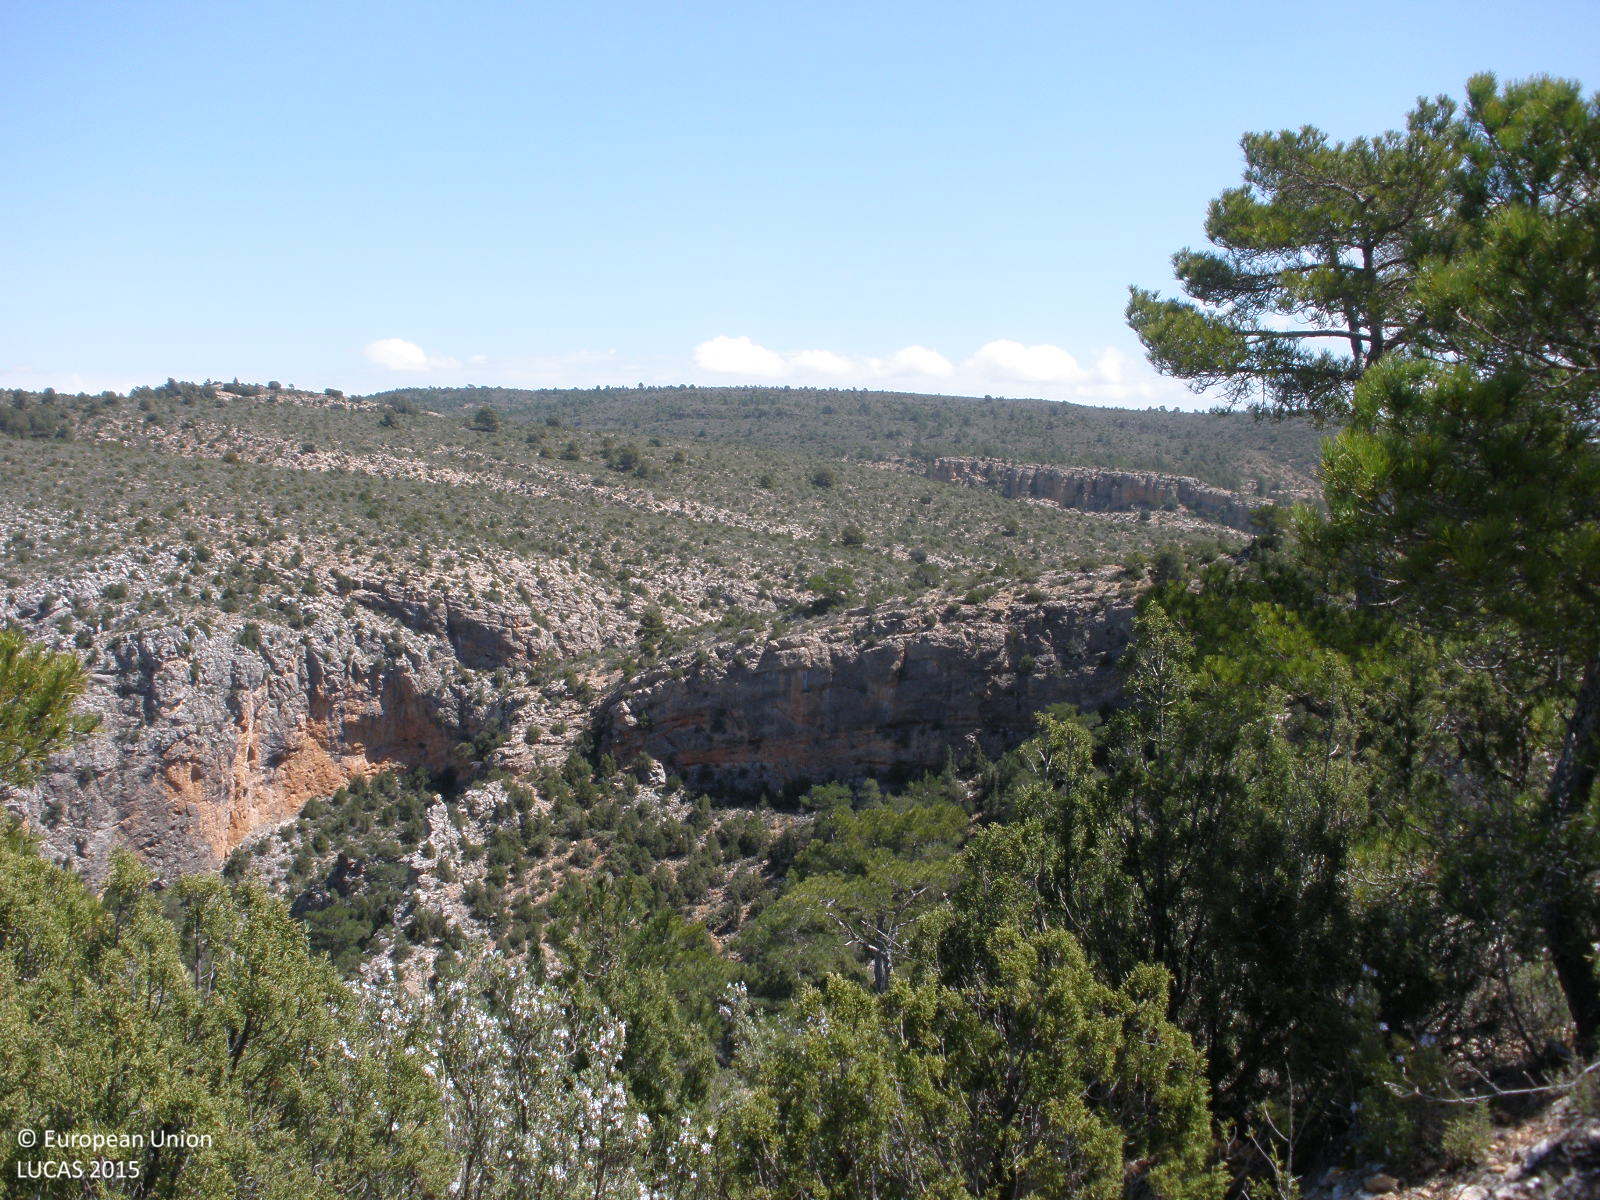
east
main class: Woodland
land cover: Pine dominated coniferous woodland
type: coniferous forest of the mediterranean region
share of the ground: 25 - 50 %
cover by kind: shrubs 50 %, coniferous forest trees 30 %, consolidated bare surface 20 %
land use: Semi-natural and natural areas not in use
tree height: < 5 m
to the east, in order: Pine dominated coniferous woodland; Shrubland without tree cover
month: April
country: ES
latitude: 40.2018
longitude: -1.2529
